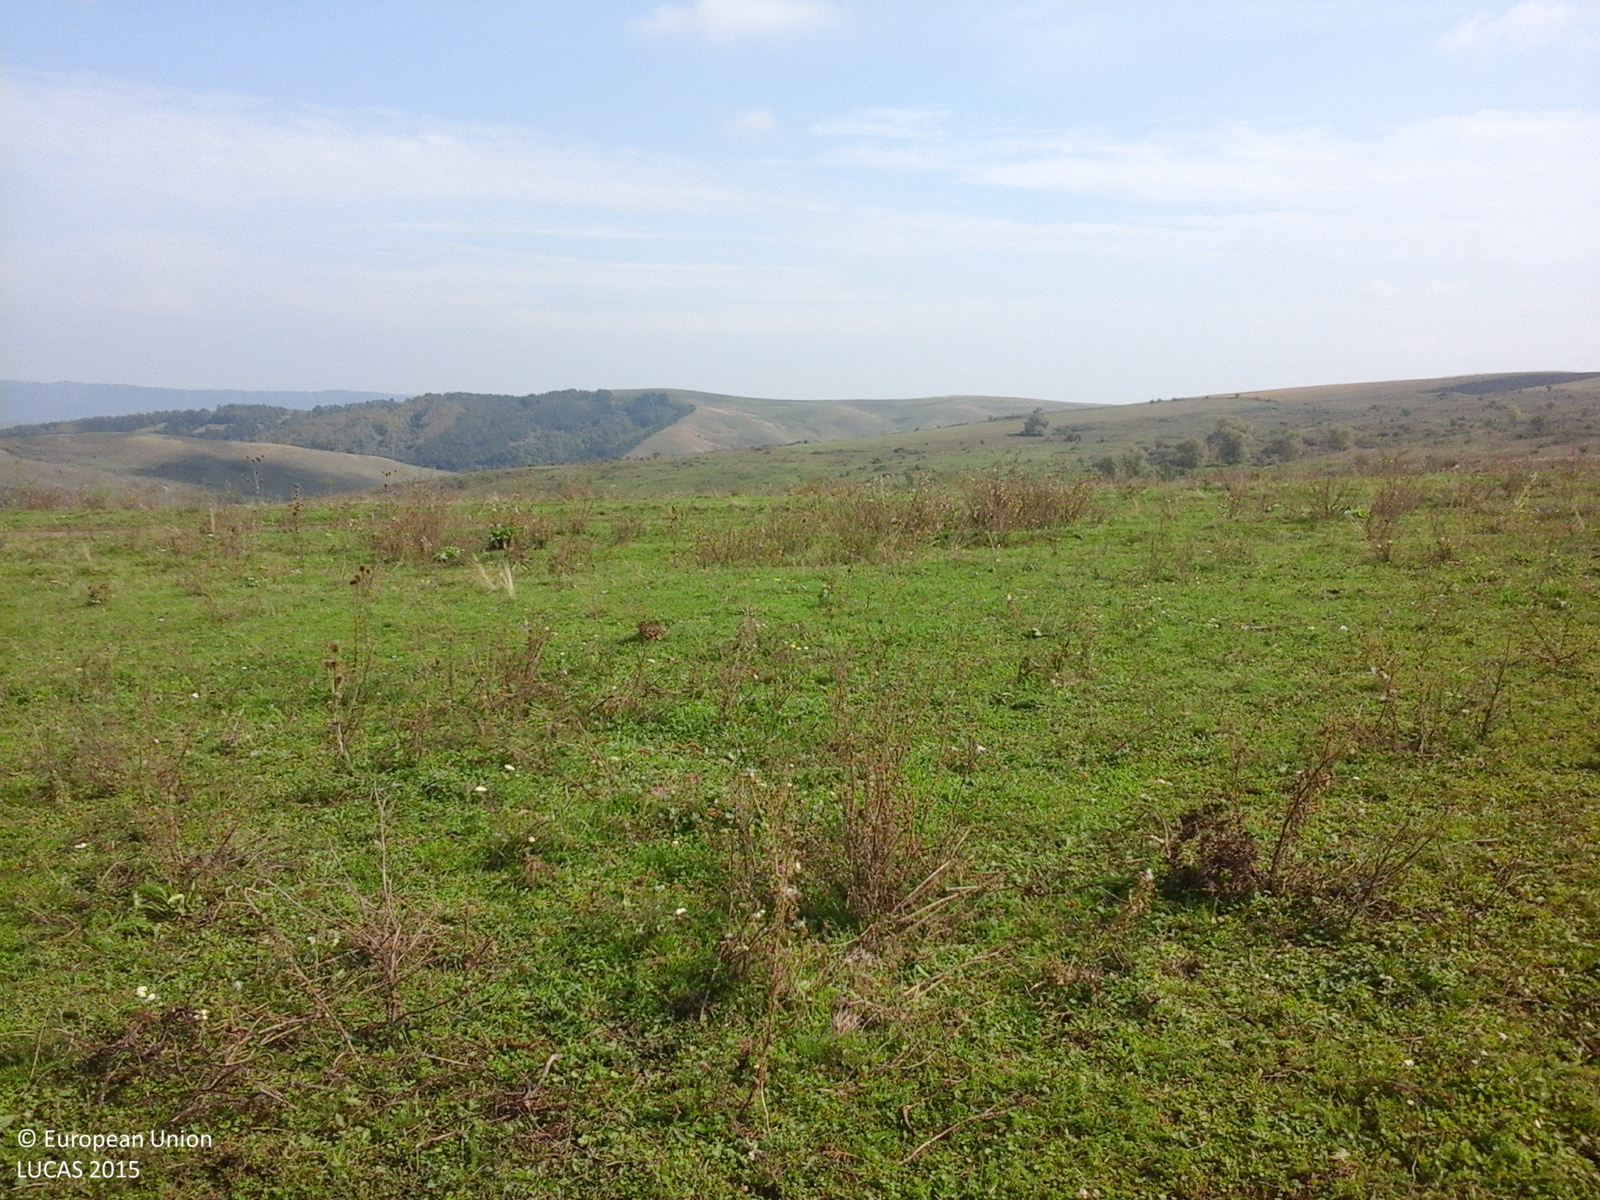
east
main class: Grassland
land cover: Spontaneously vegetated surfaces
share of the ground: > 75 %
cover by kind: herbaceous plants 100 %
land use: Agriculture (excluding fallow land and kitchen gardens)
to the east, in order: Spontaneously vegetated surfaces; Tracks; Spontaneously vegetated surfaces; Grassland with sparse tree/shrub cover; Ditches and canals; Grassland with sparse tree/shrub cover
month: October
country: RO
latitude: 46.4657
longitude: 23.8645
